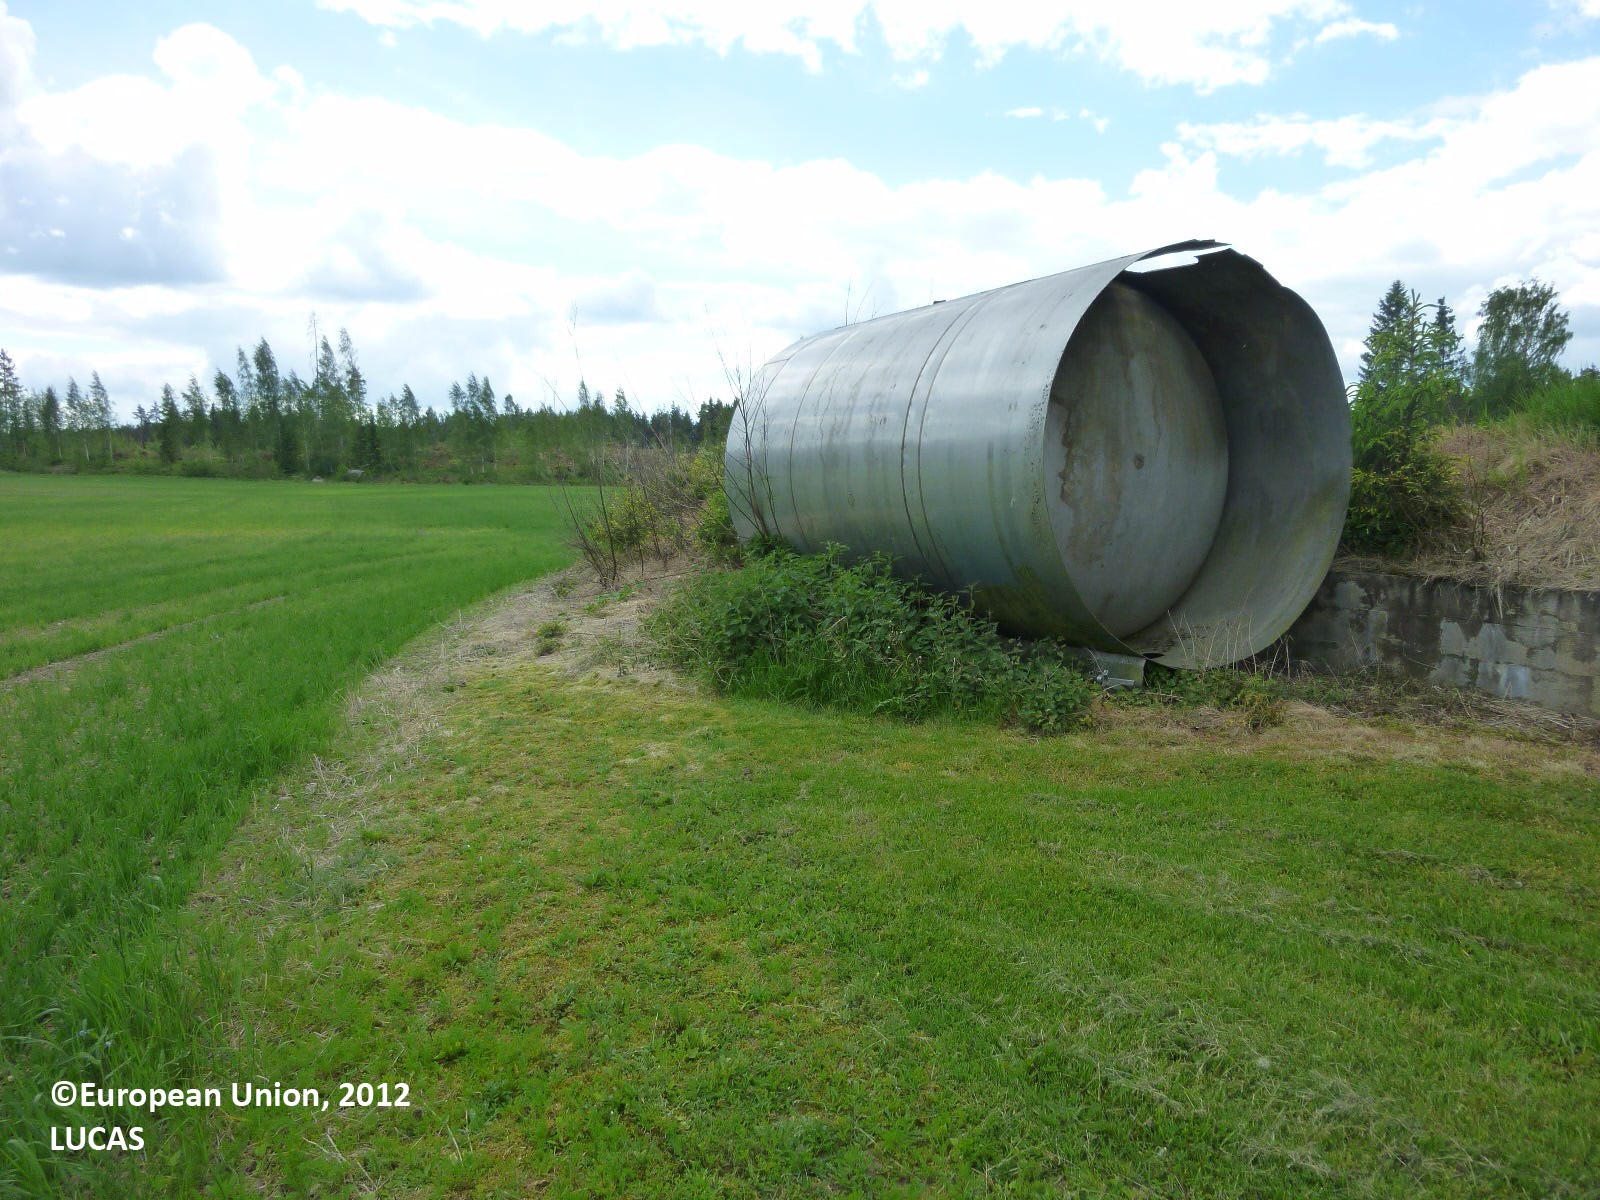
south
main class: Cropland
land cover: Barley
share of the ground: 50 - 75 %
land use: Agriculture (excluding fallow land and kitchen gardens)
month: June
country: FI
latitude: 61.4073
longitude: 22.5586
